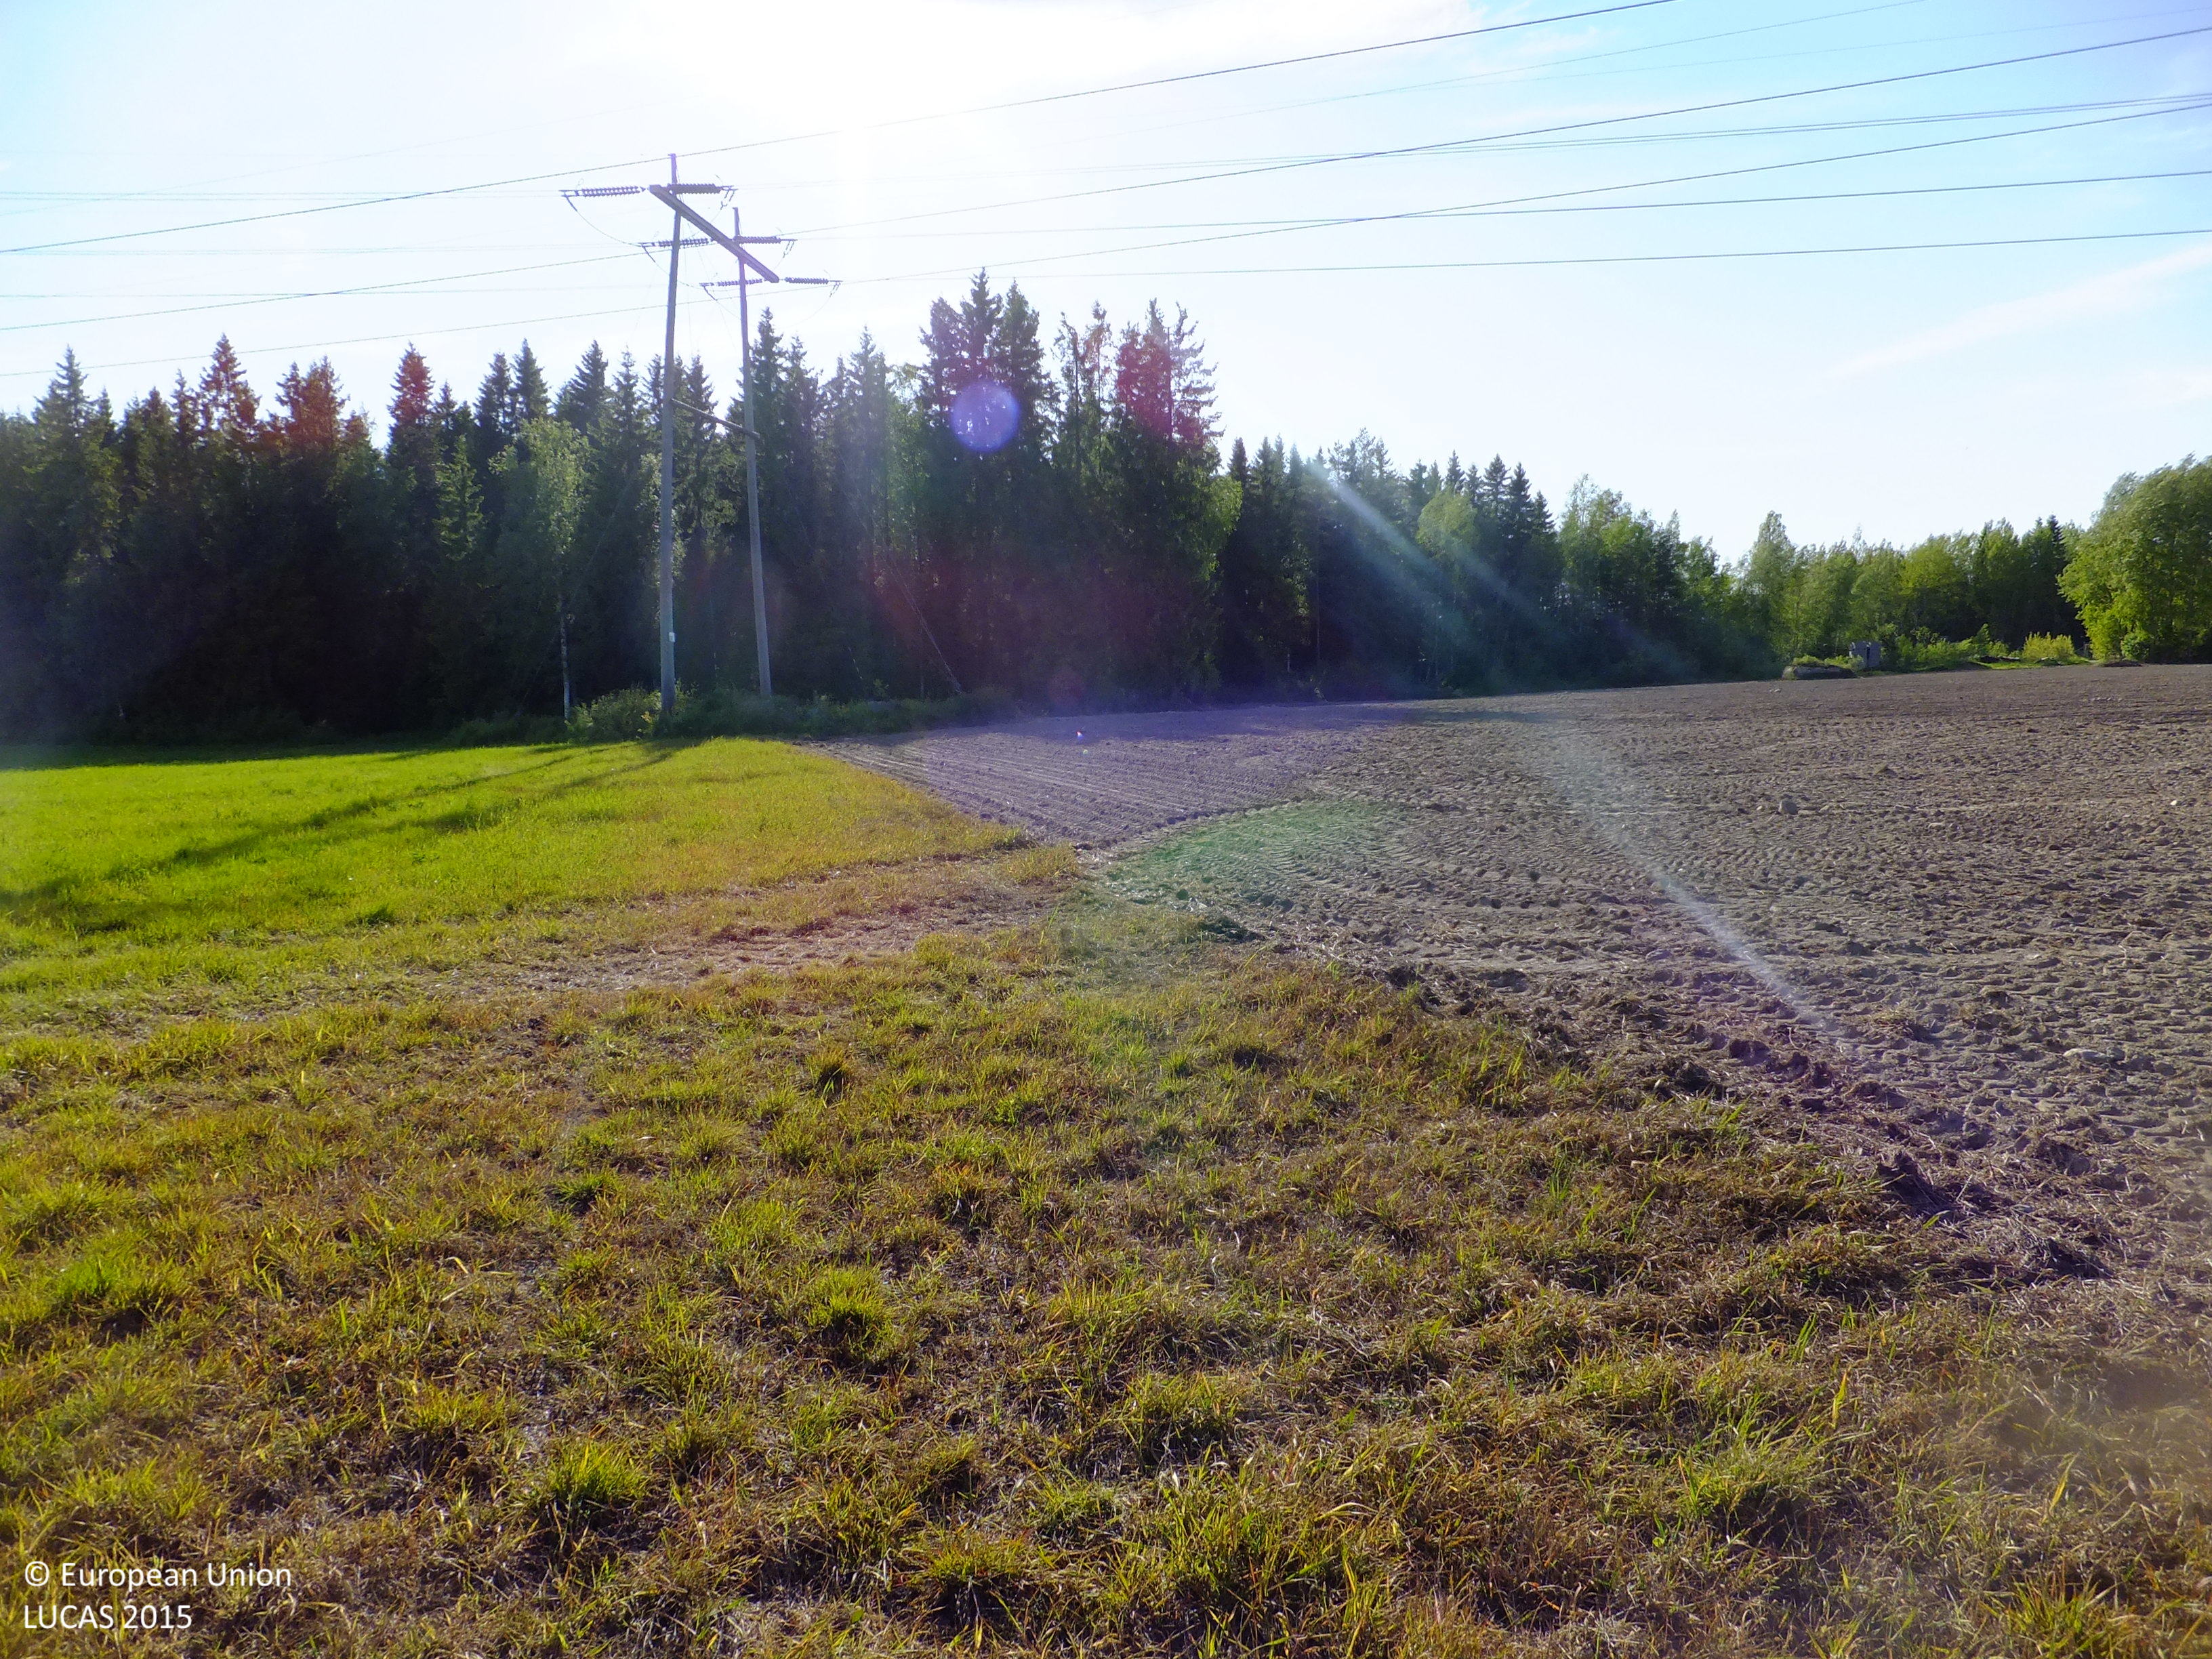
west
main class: Grassland
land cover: Grassland without tree/shrub cover
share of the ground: > 75 %
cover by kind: herbaceous plants 100 %
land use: Agriculture (excluding fallow land and kitchen gardens)
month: June
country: FI
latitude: 63.5050
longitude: 22.6464
